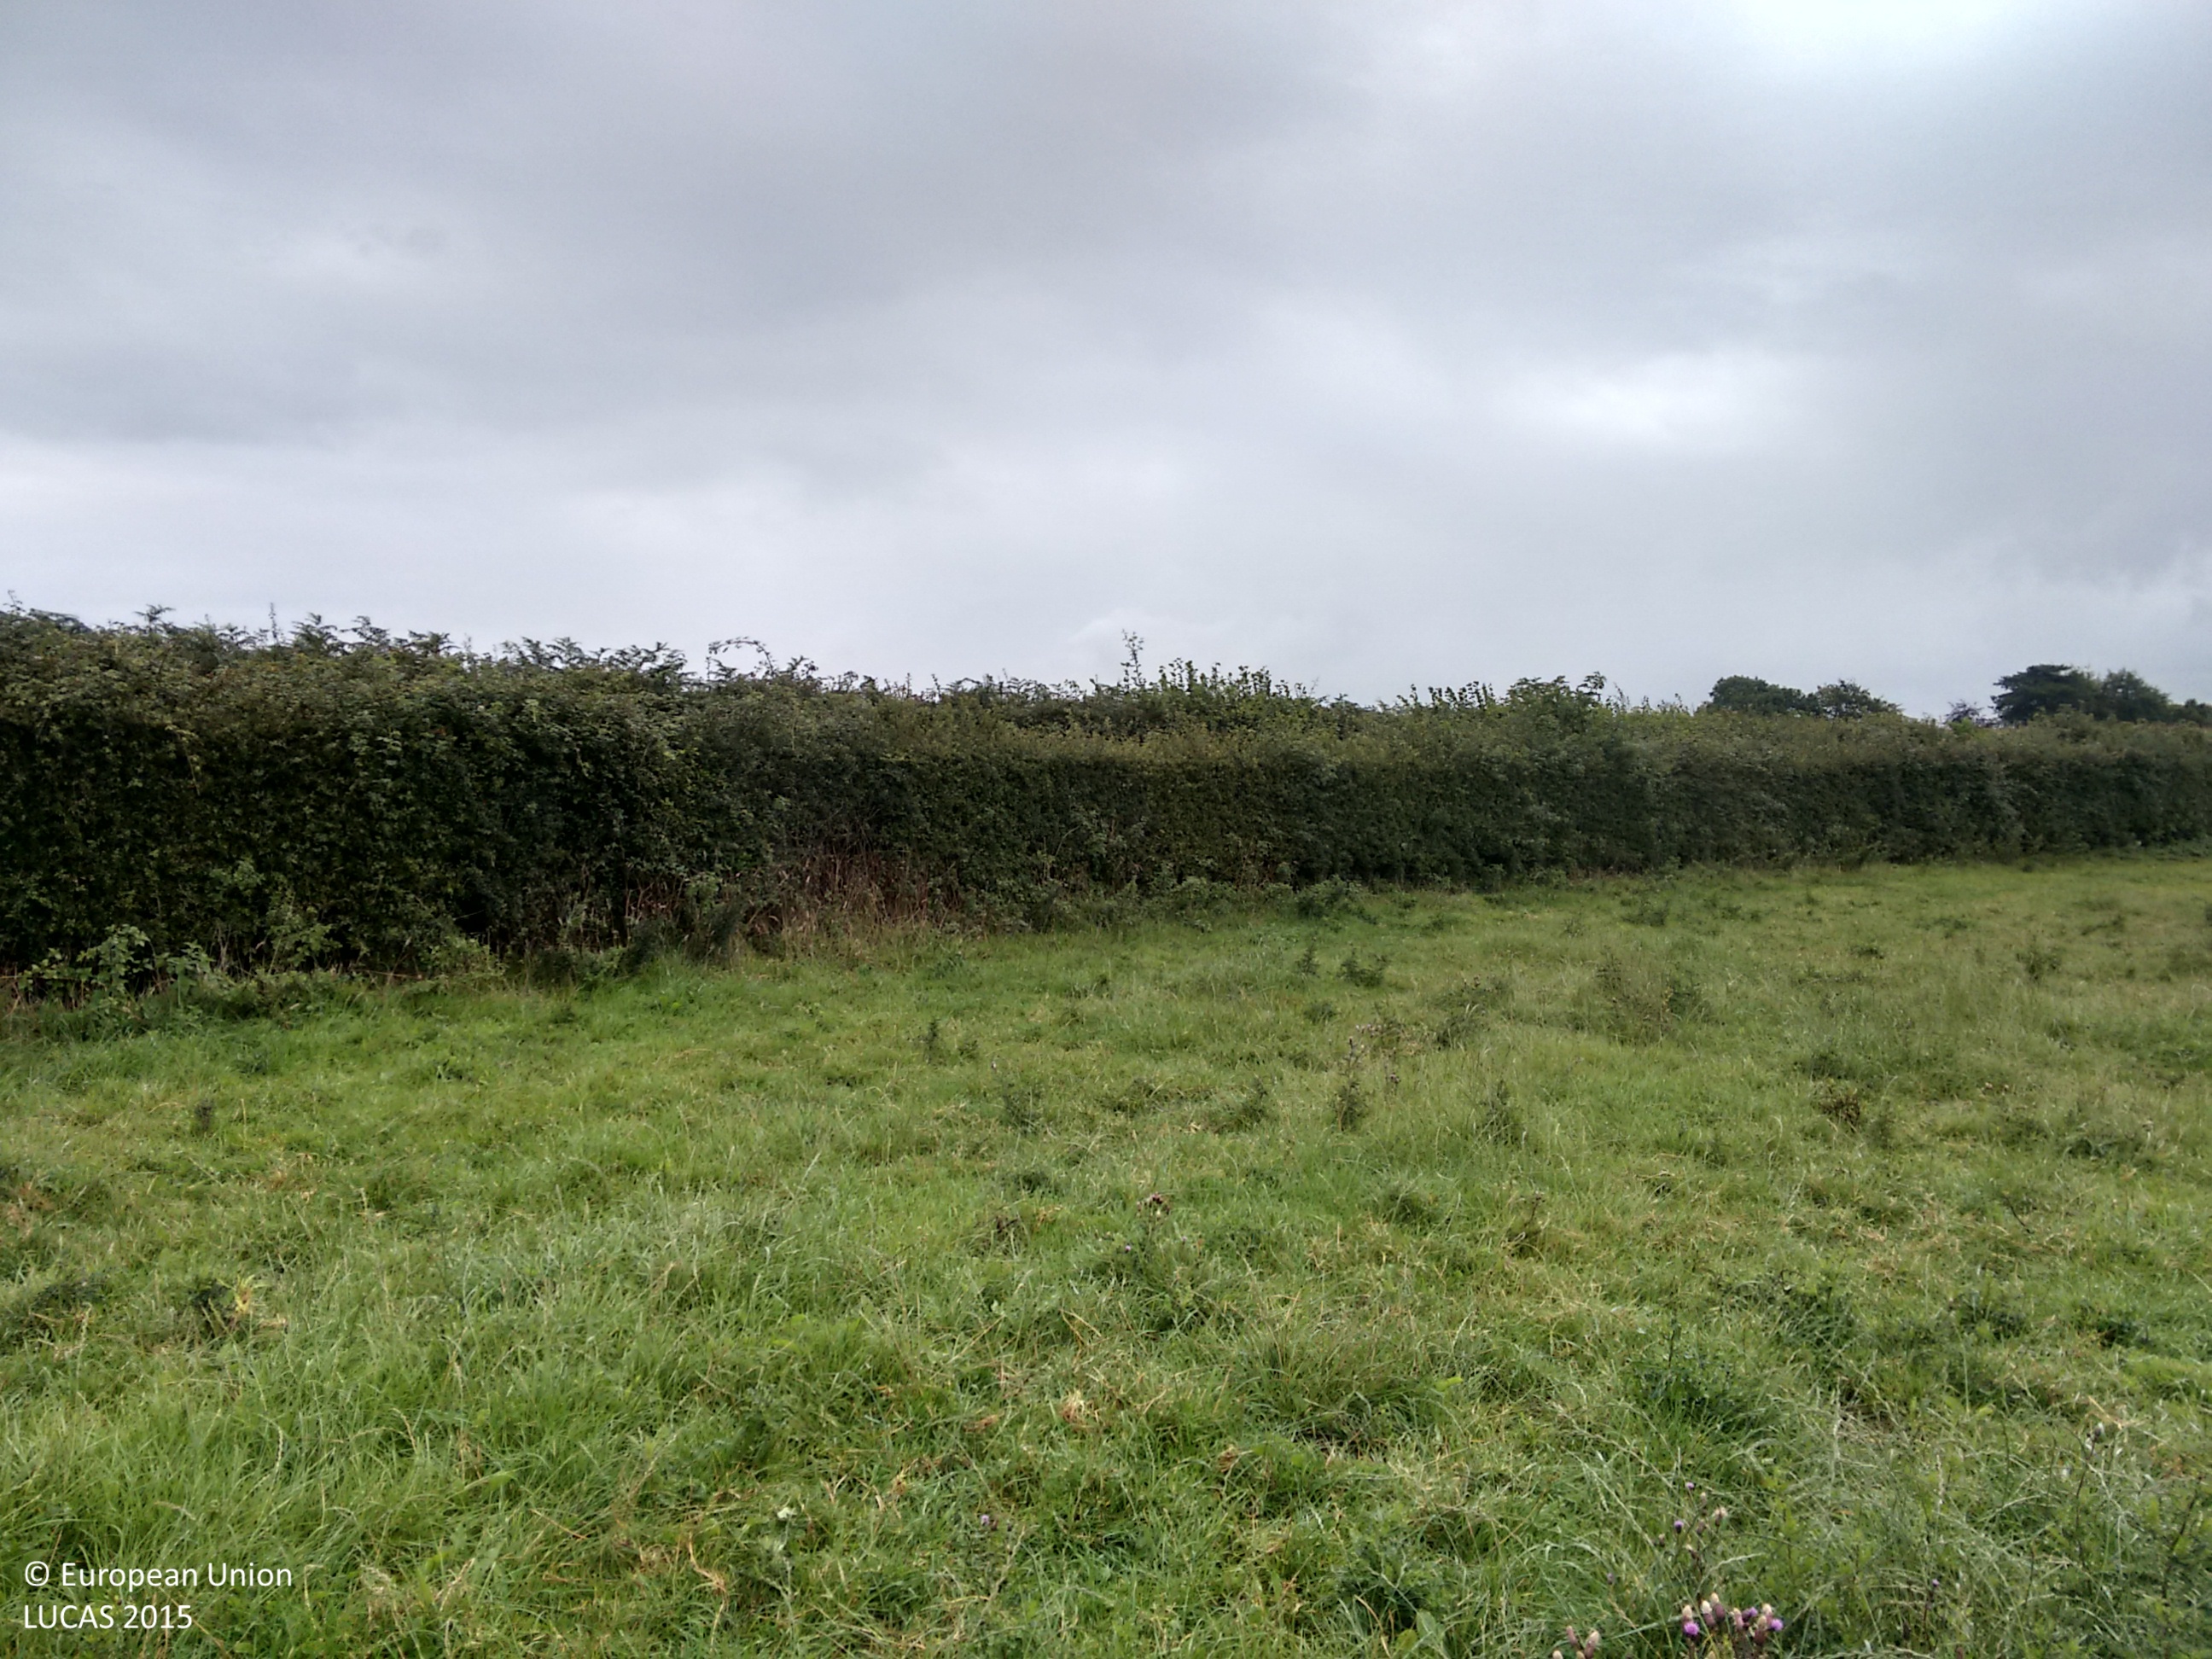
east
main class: Grassland
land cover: Grassland without tree/shrub cover
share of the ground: > 75 %
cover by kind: herbaceous plants 100 %
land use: Agriculture (excluding fallow land and kitchen gardens)
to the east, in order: Grassland without tree/shrub cover; Managed hedges; Grass margins; Paved roads, cycling and walking lanes; Grass margins; Managed hedges; Maize; Conifer hedges; Fences; Grassland without tree/shrub cover; Fences; Artificial constructions in urban areas; Grassland without tree/shrub cover; Broadleaved woodland
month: September
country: GB
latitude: 52.9370
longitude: -2.9743
